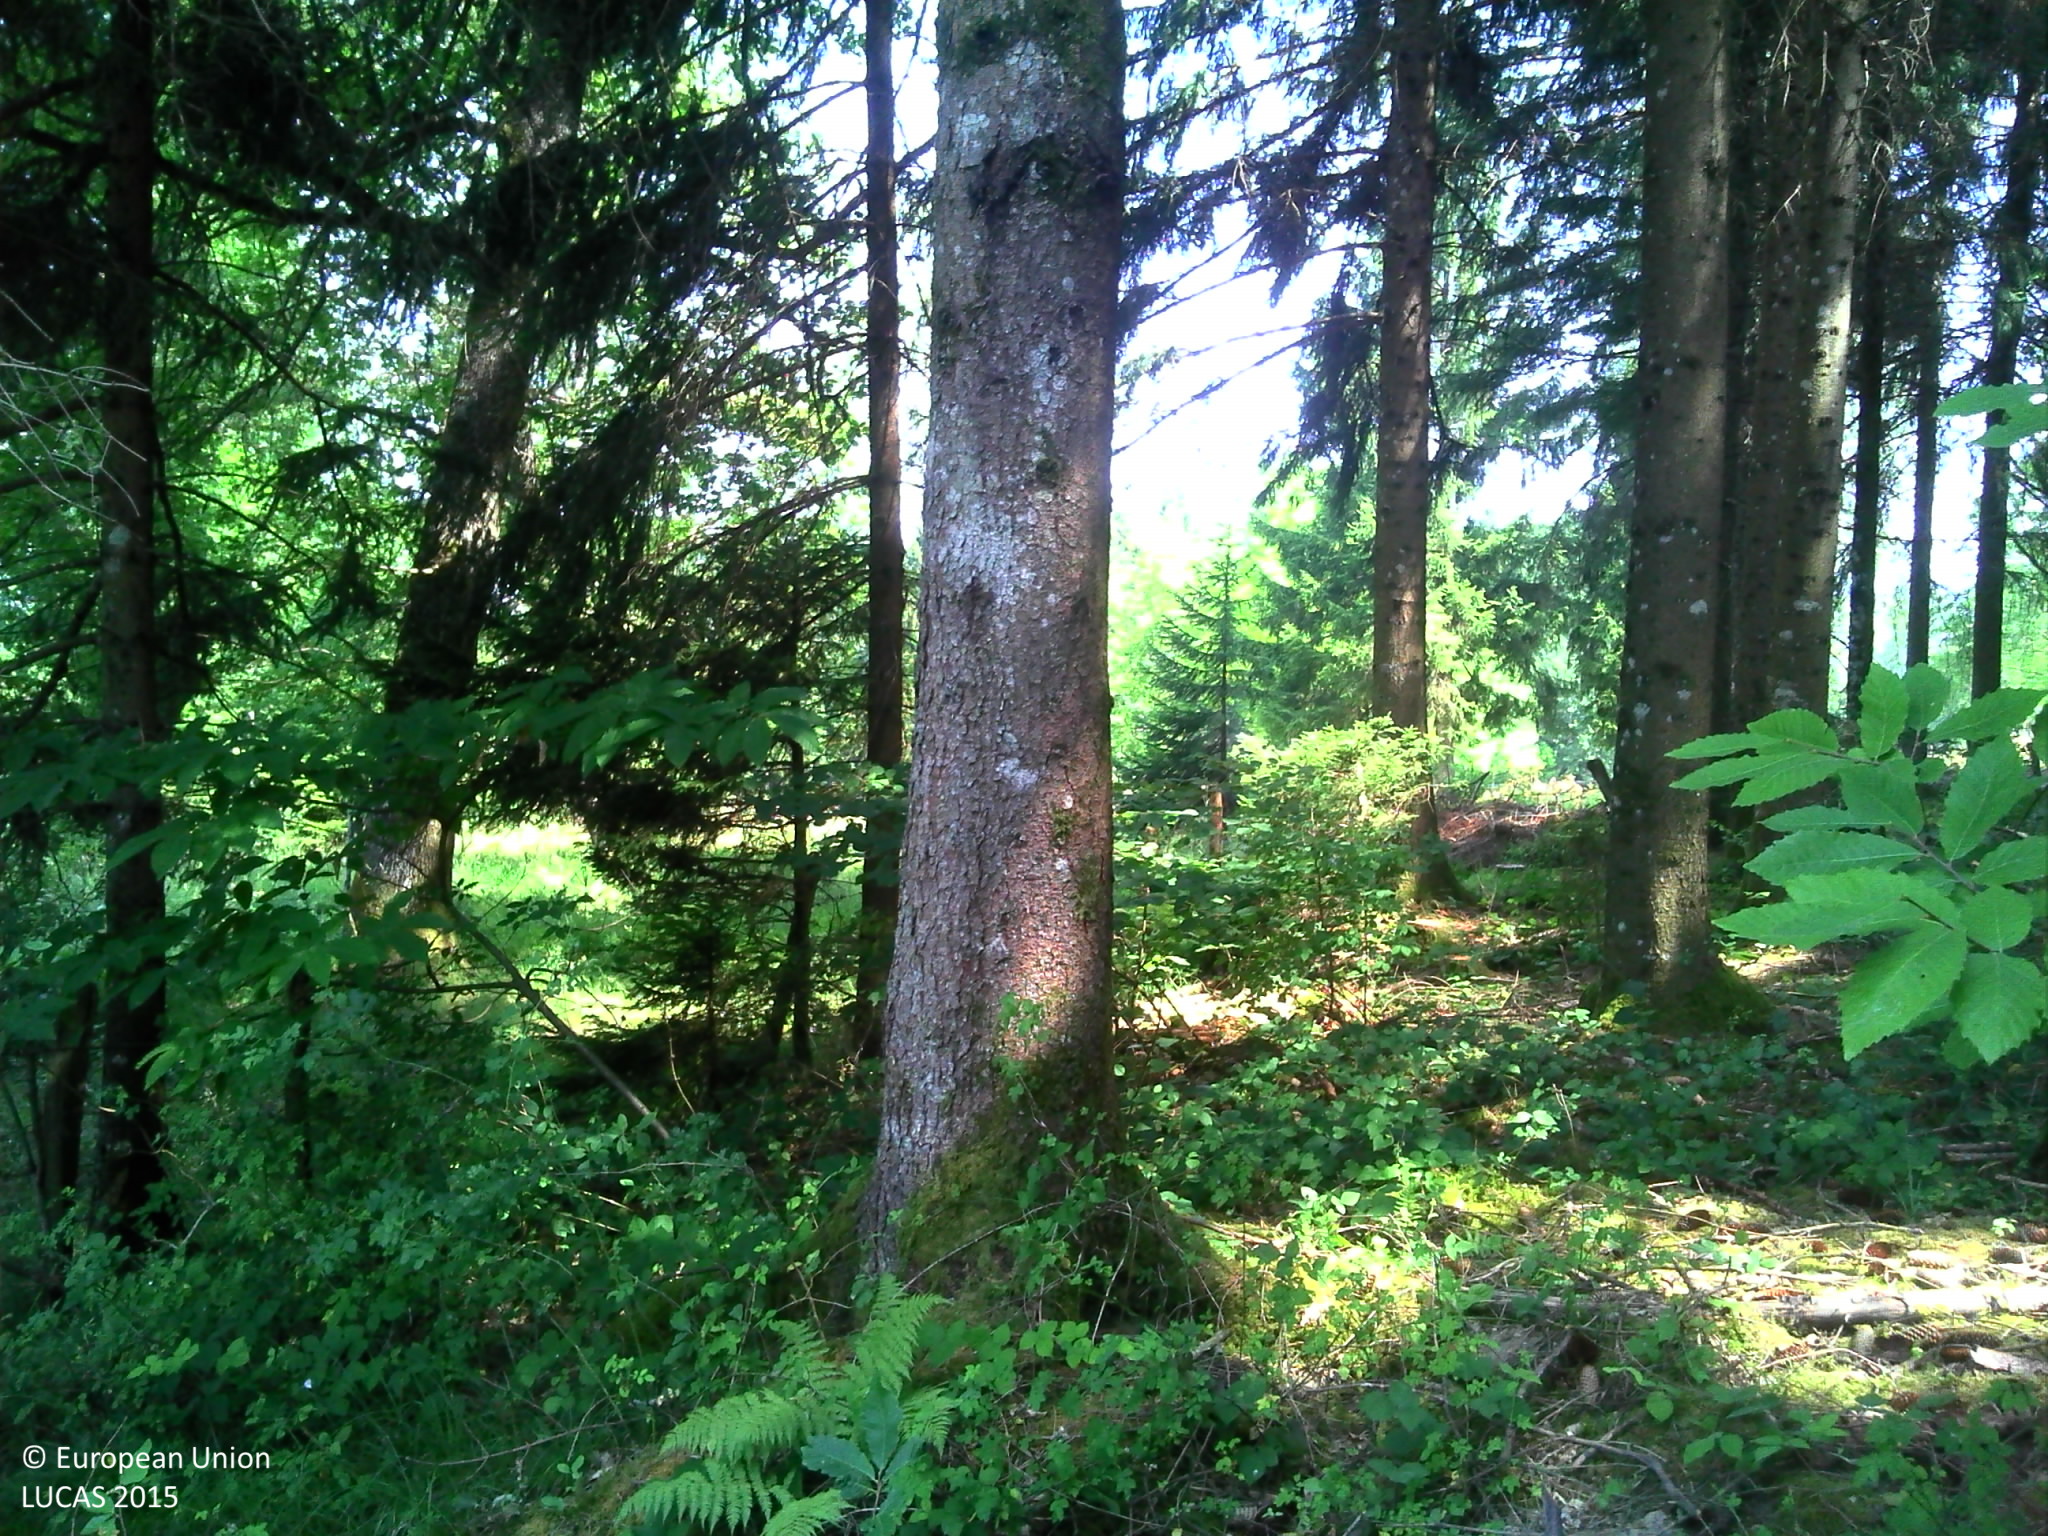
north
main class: Woodland
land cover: Spruce dominated coniferous woodland
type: alpine coniferous forest
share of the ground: > 75 %
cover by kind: coniferous forest trees 85 %, broadleaved forest trees 5 %, herbaceous plants 5 %, lichens and mosses 5 %
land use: Forestry
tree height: > 5 m
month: July
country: FR
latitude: 45.8133
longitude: 6.1562
